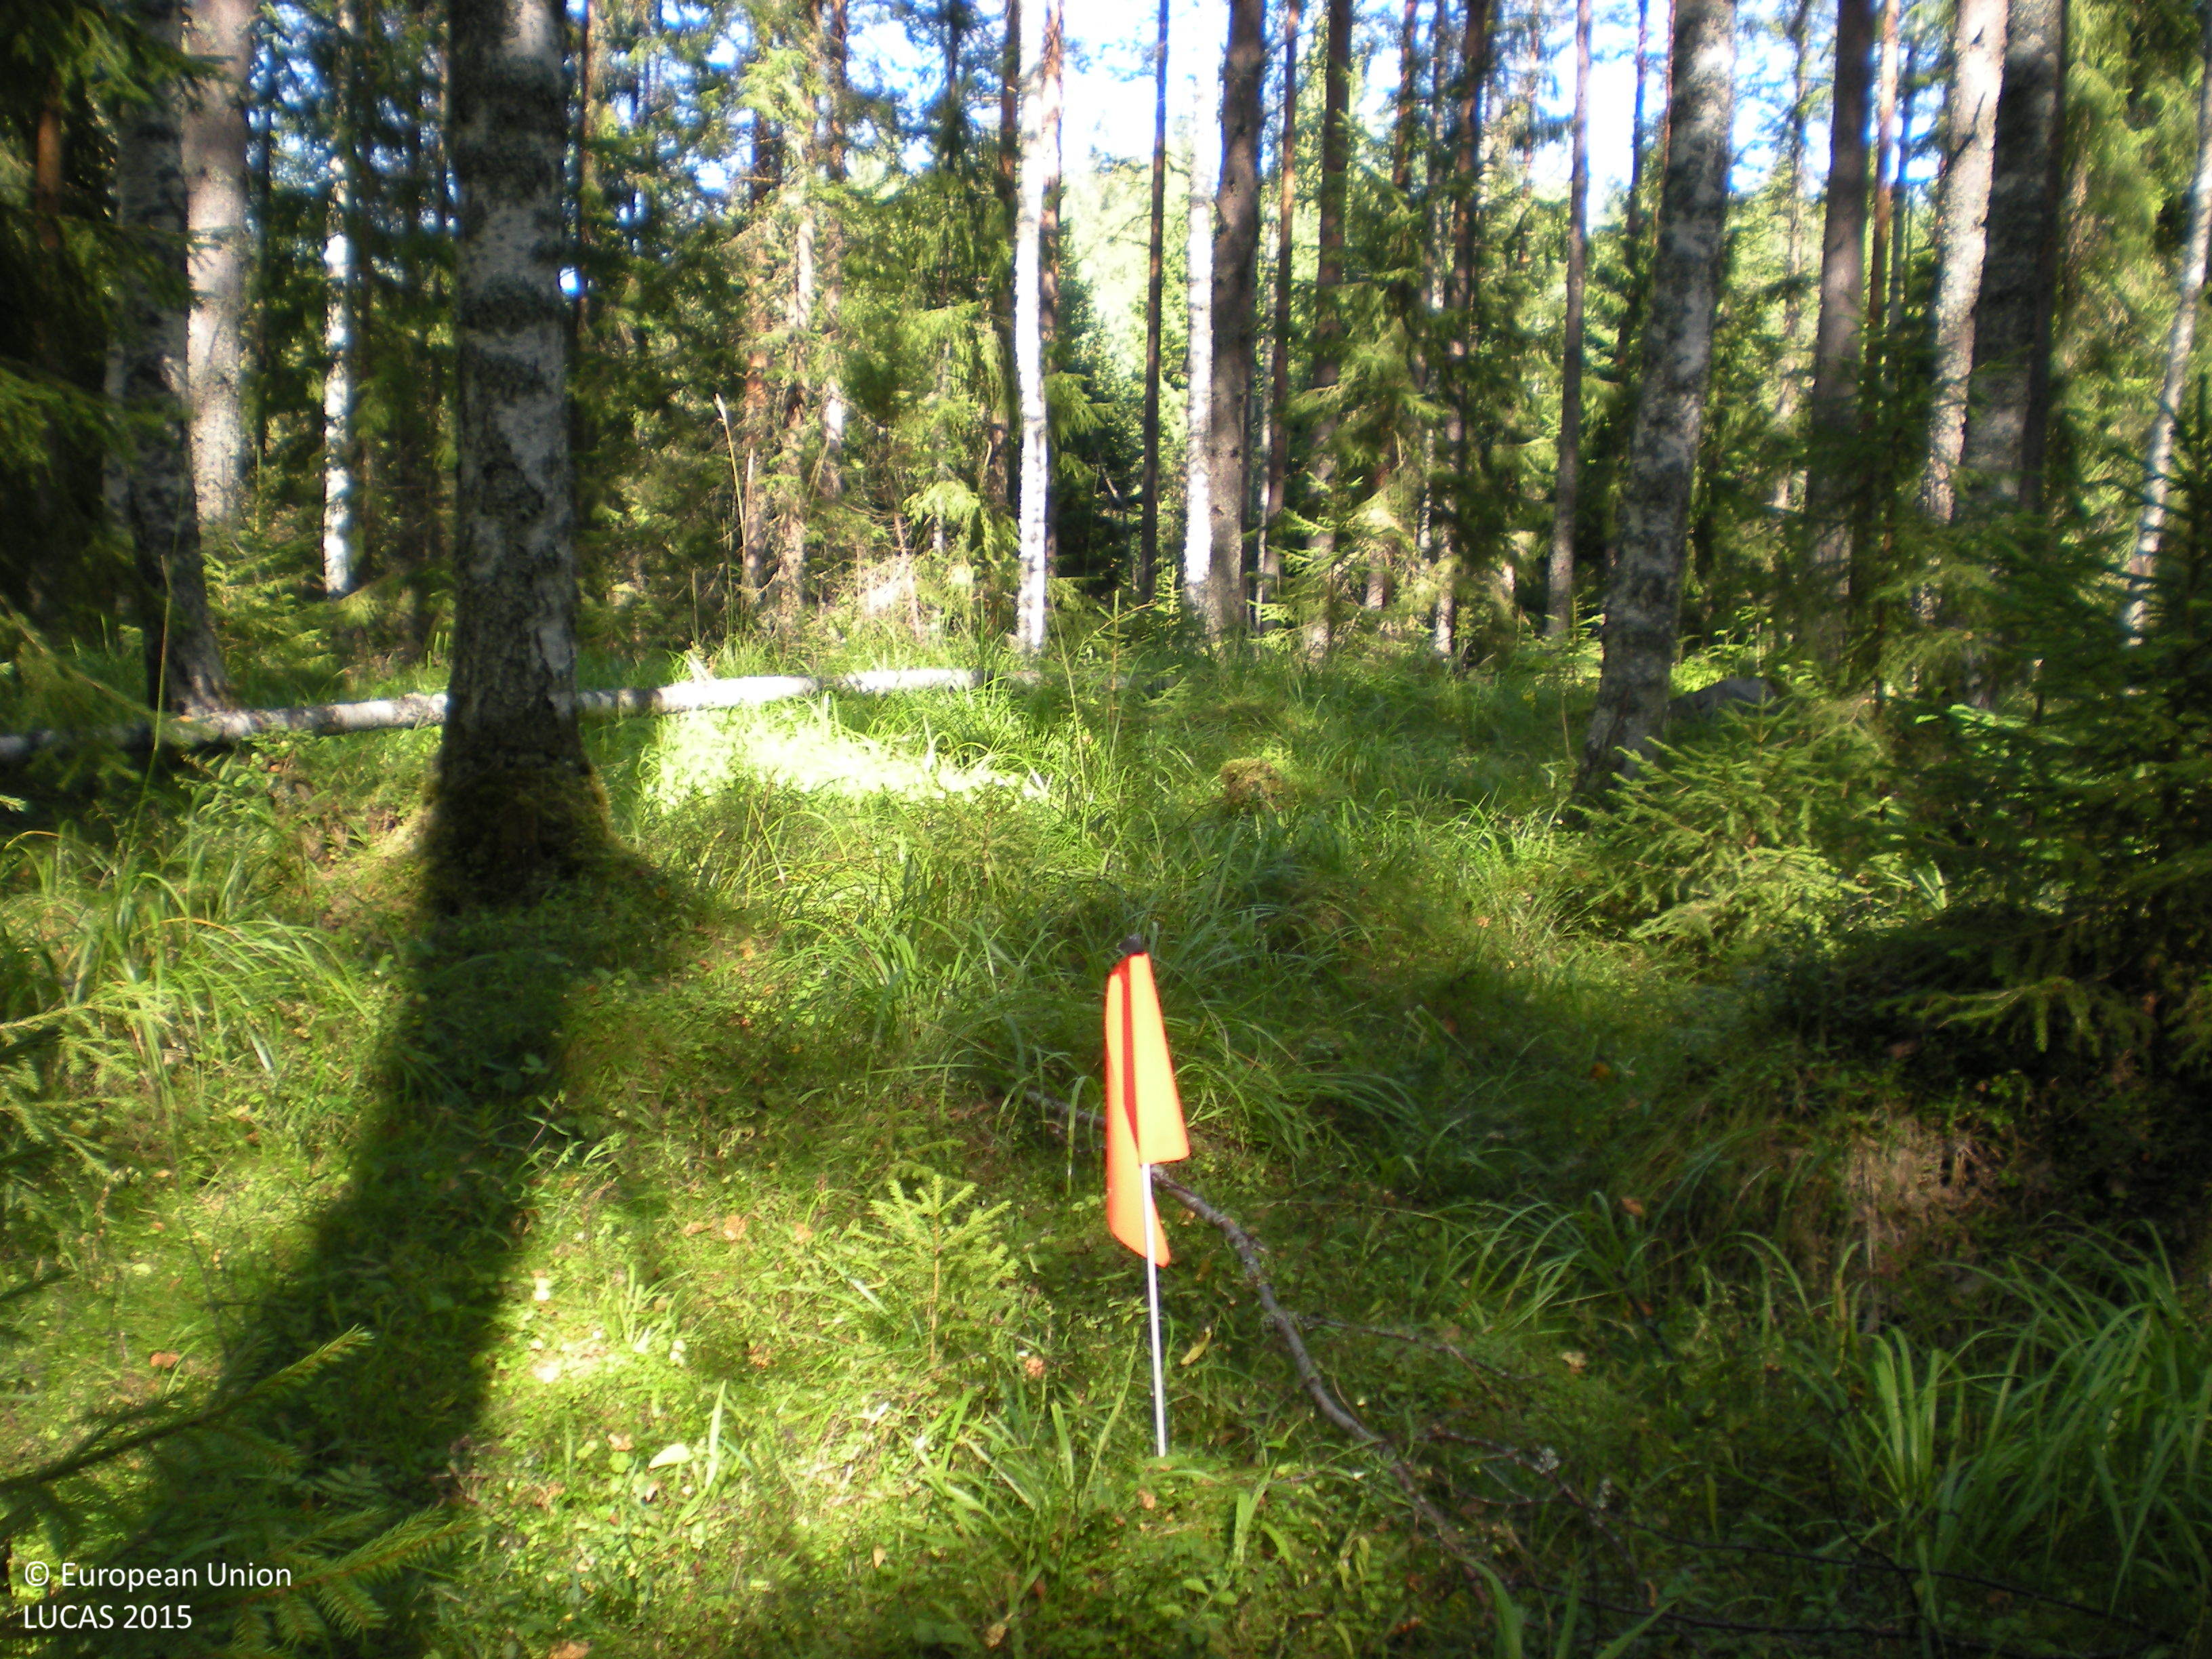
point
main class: Woodland
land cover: Pine dominated mixed woodland
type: boreal forest
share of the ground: 50 - 75 %
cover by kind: coniferous forest trees 50 %, broadleaved forest trees 20 %, herbaceous plants 15 %, shrubs 10 %, lichens and mosses 5 %
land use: Forestry
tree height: > 5 m
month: August
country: SE
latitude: 60.5990
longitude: 17.0929
